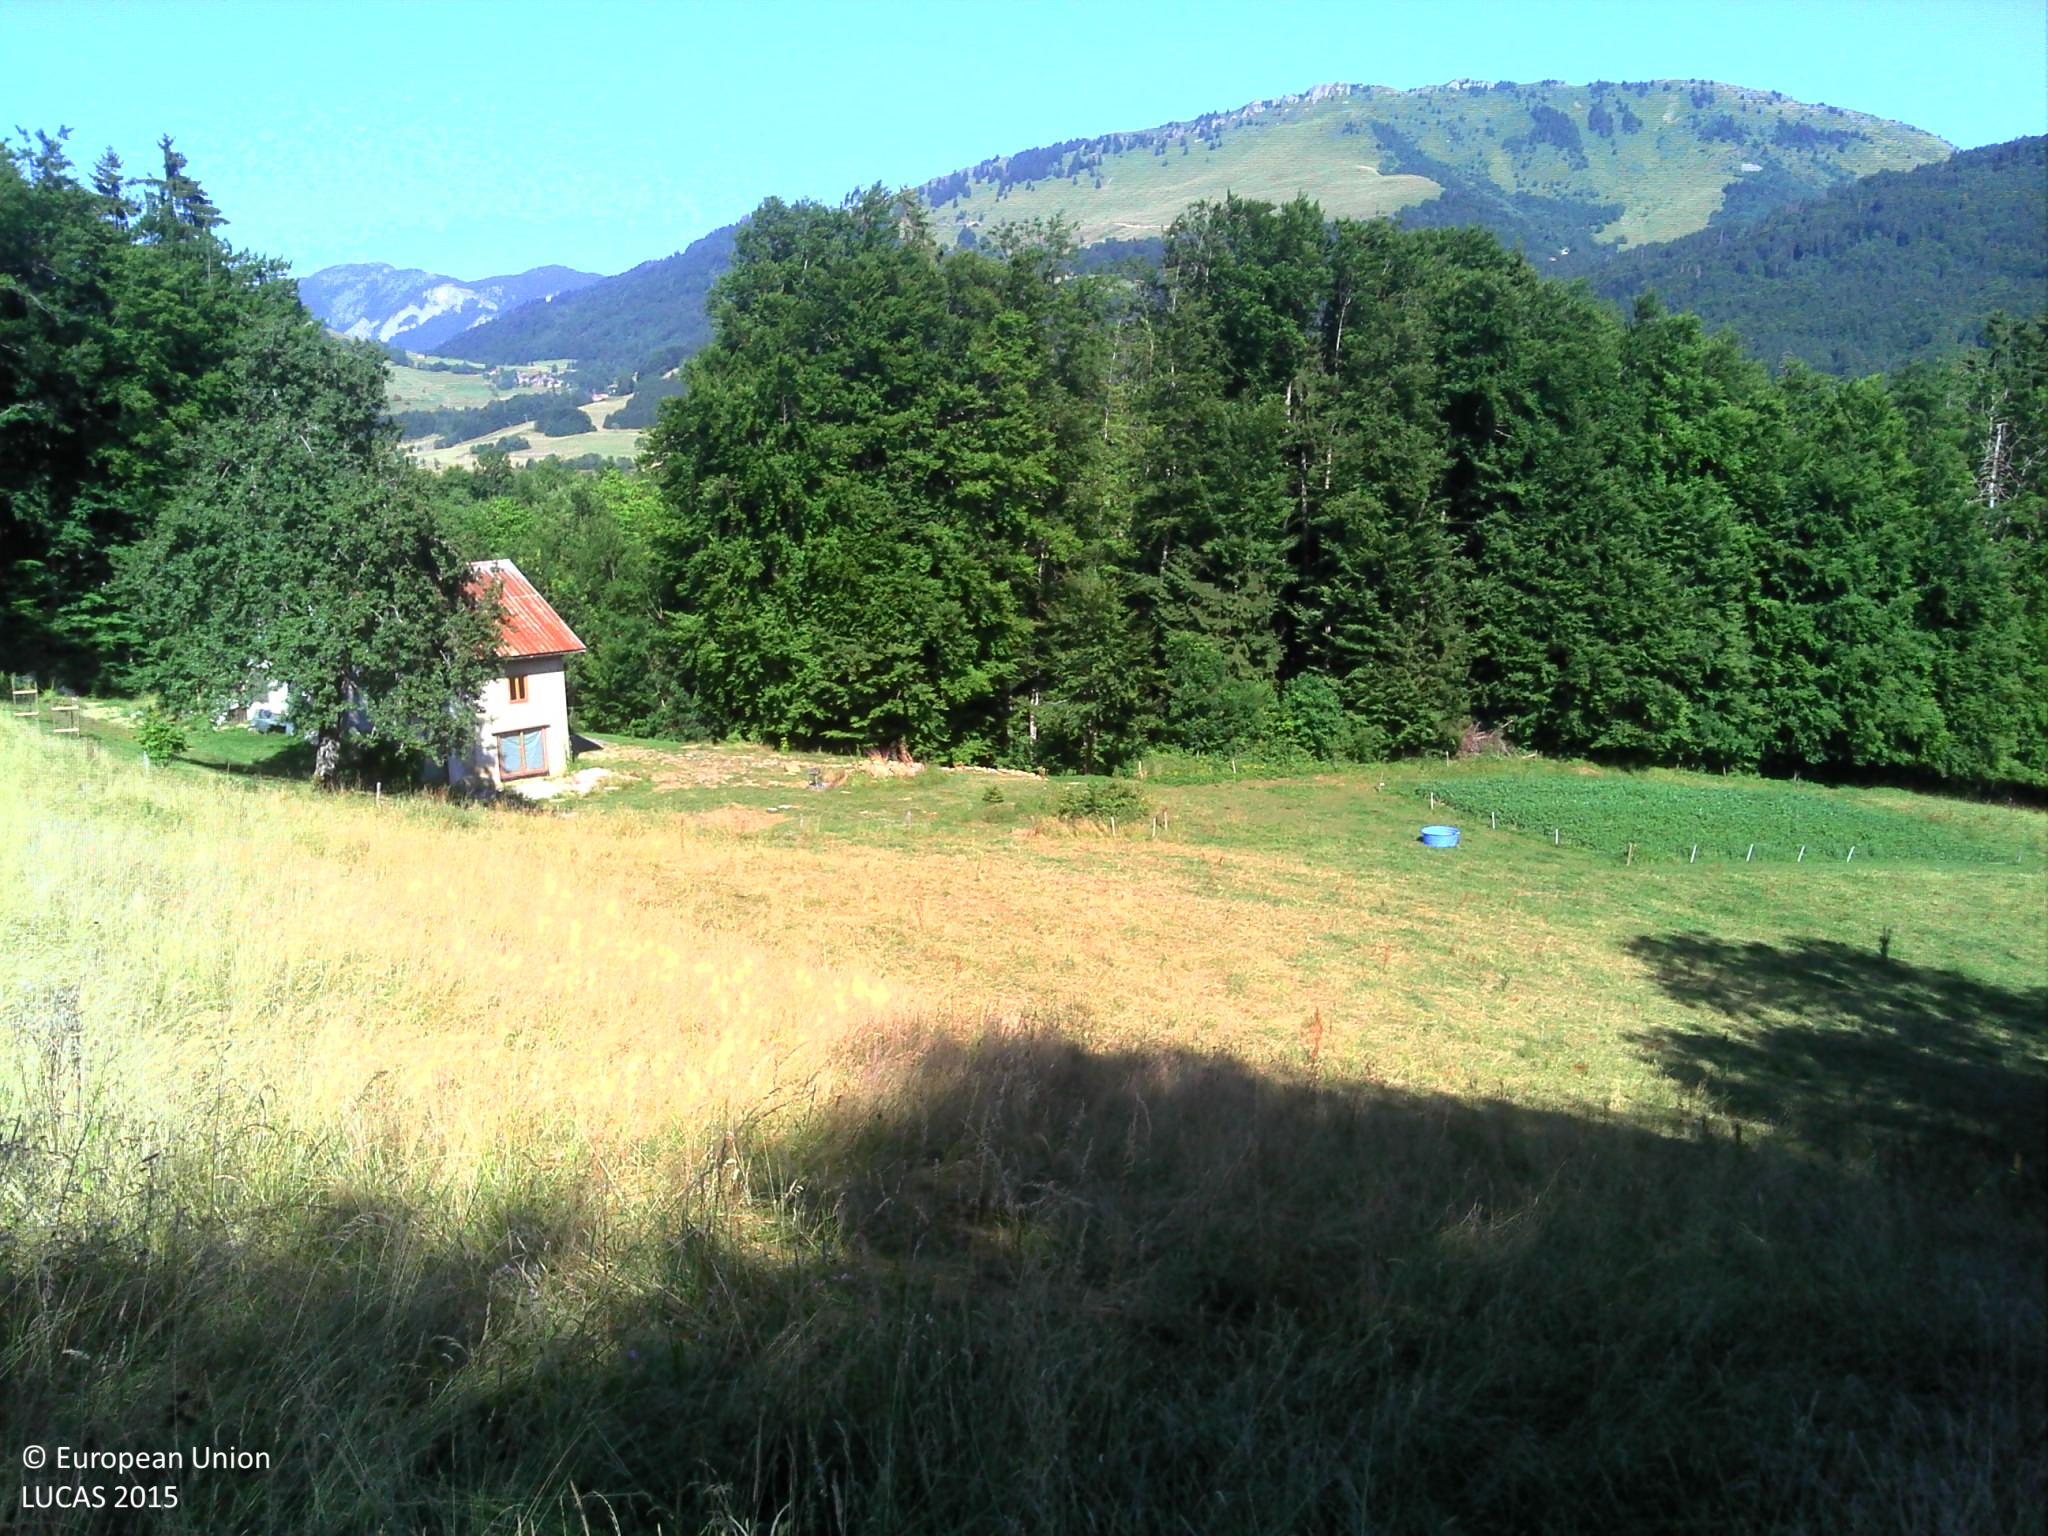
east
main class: Grassland
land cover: Grassland without tree/shrub cover
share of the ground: > 75 %
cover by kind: herbaceous plants 100 %
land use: Agriculture (excluding fallow land and kitchen gardens)
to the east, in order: Grassland without tree/shrub cover; Fences; Dry stone walls; Paved roads, cycling and walking lanes; Spontaneously vegetated surfaces; Rivers and streams; Broadleaved woodland; Fences; Grass margins; Paved roads, cycling and walking lanes; Grass margins; Fences; Broadleaved woodland; Grassland without tree/shrub cover
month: July
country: FR
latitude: 46.2378
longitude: 6.4372
